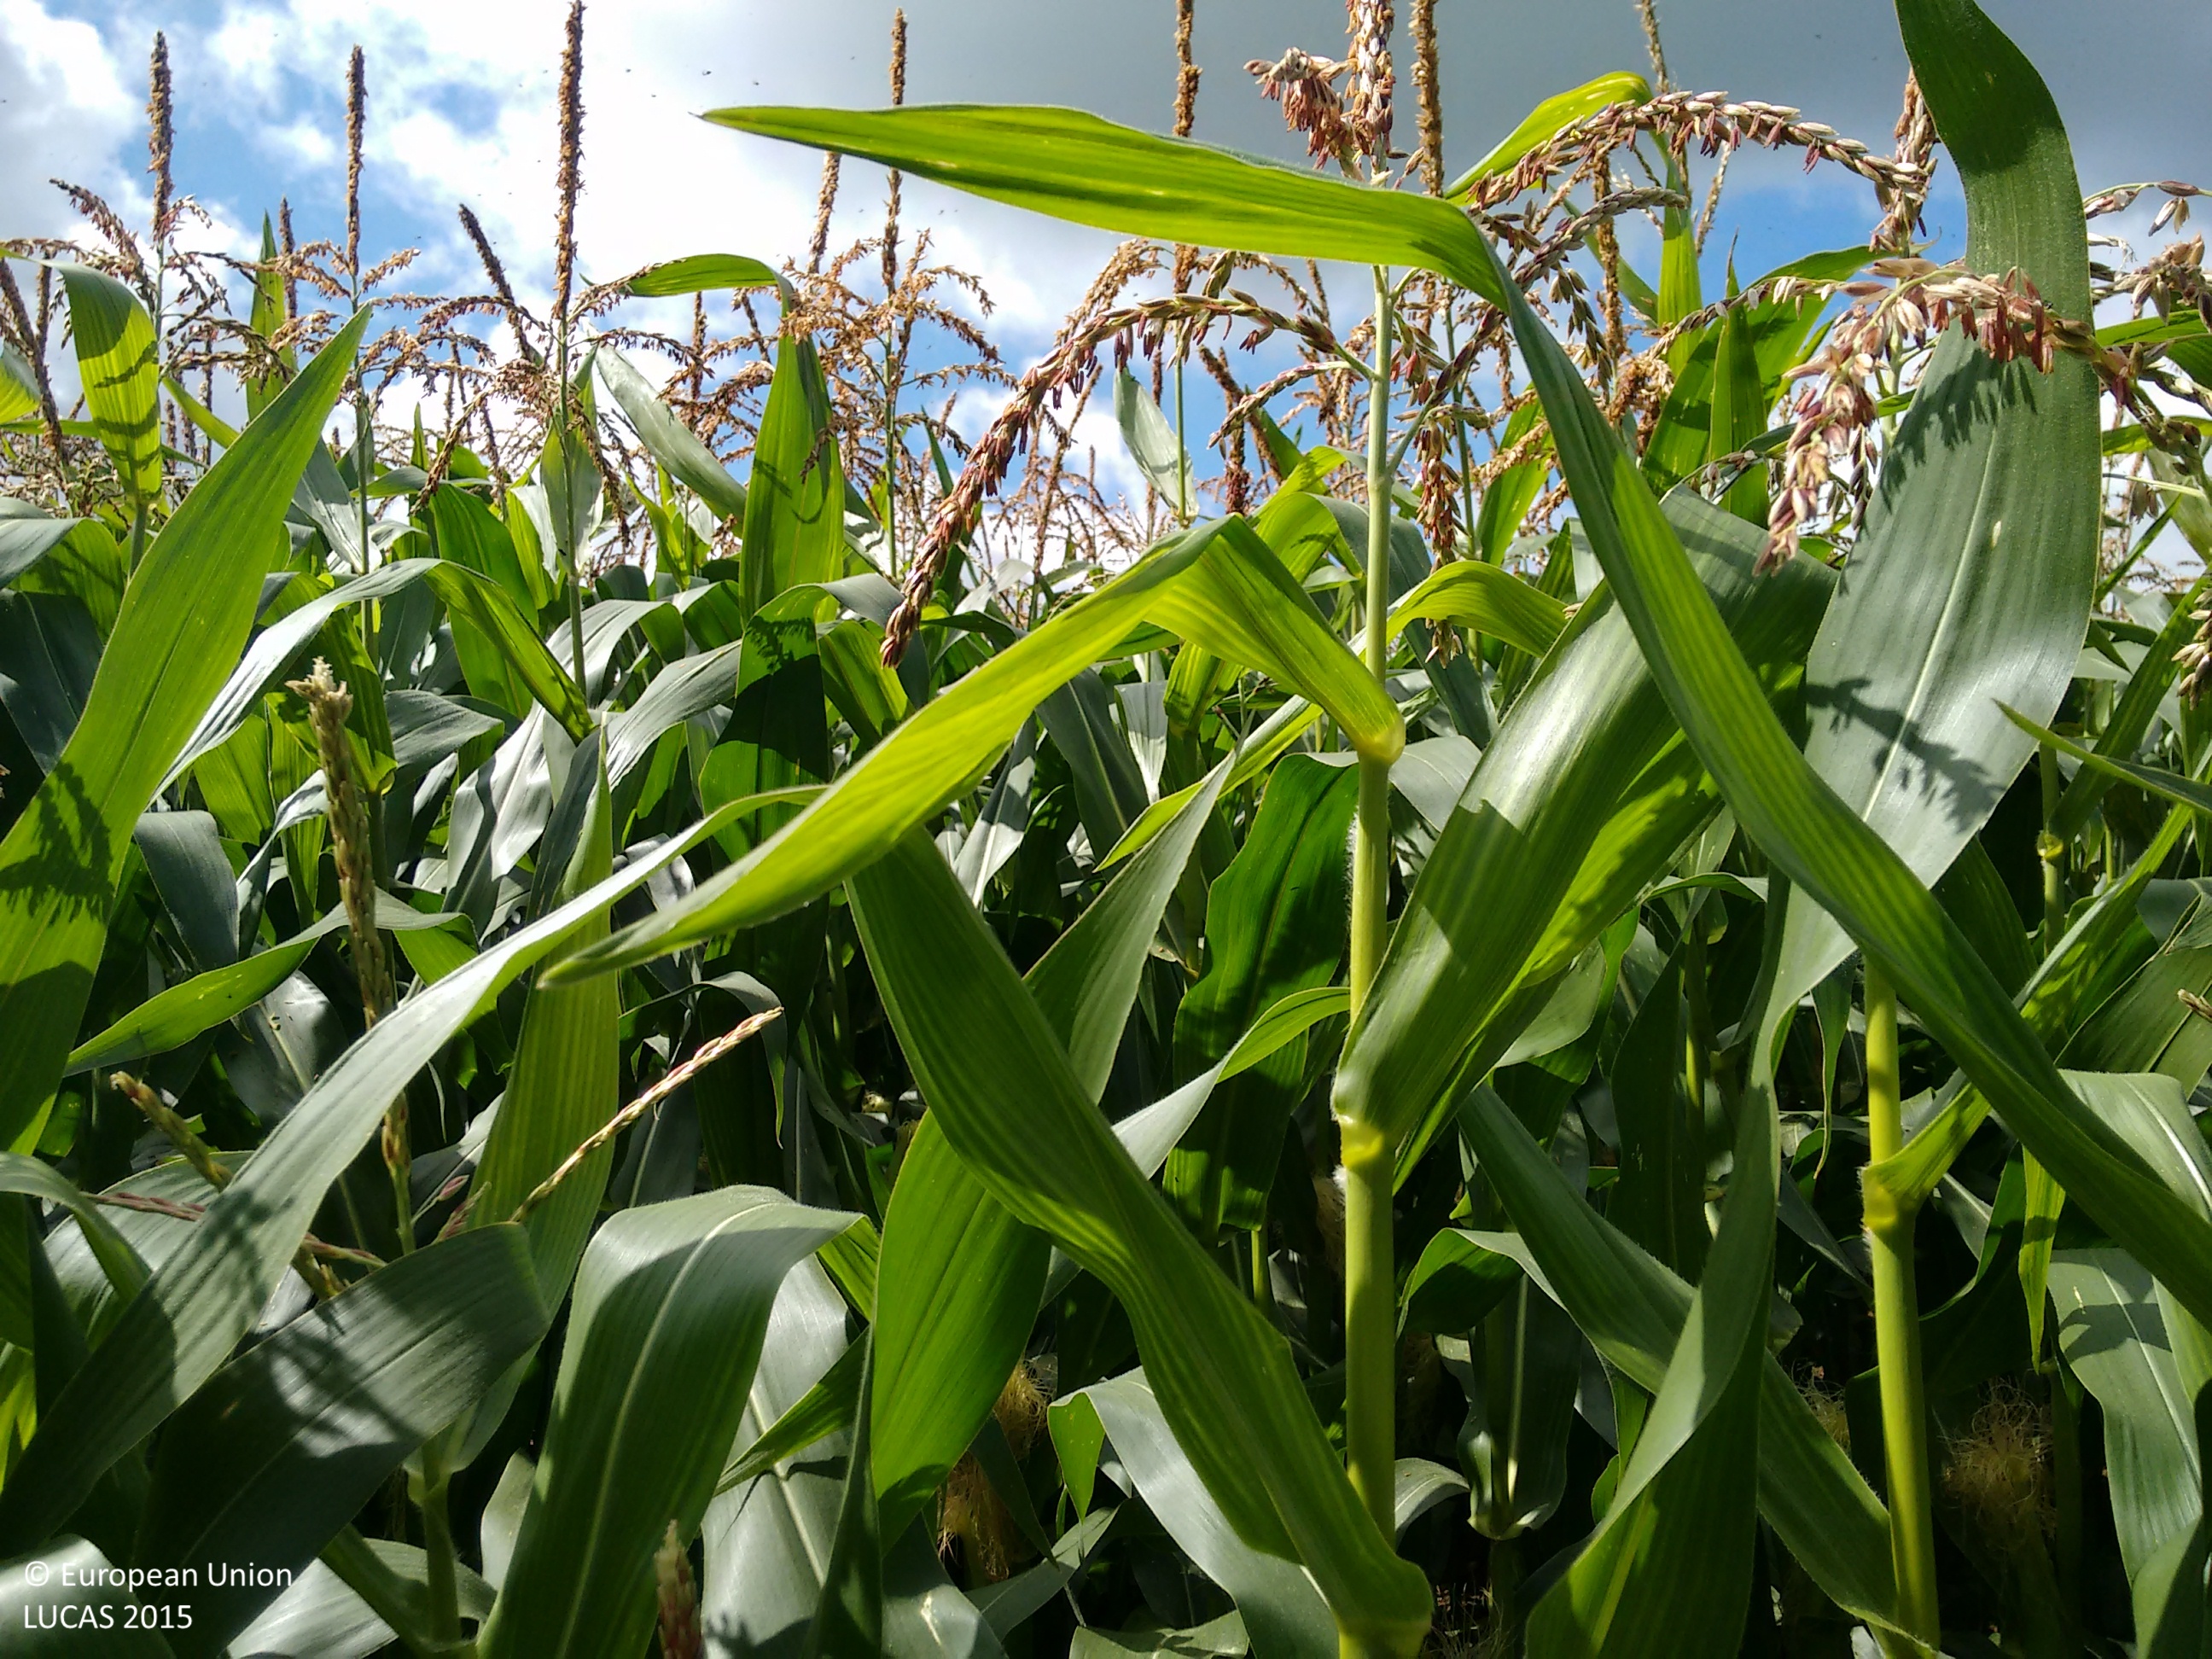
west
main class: Cropland
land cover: Maize
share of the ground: > 75 %
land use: Agriculture (excluding fallow land and kitchen gardens)
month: September
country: GB
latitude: 50.5502
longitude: -4.1971
